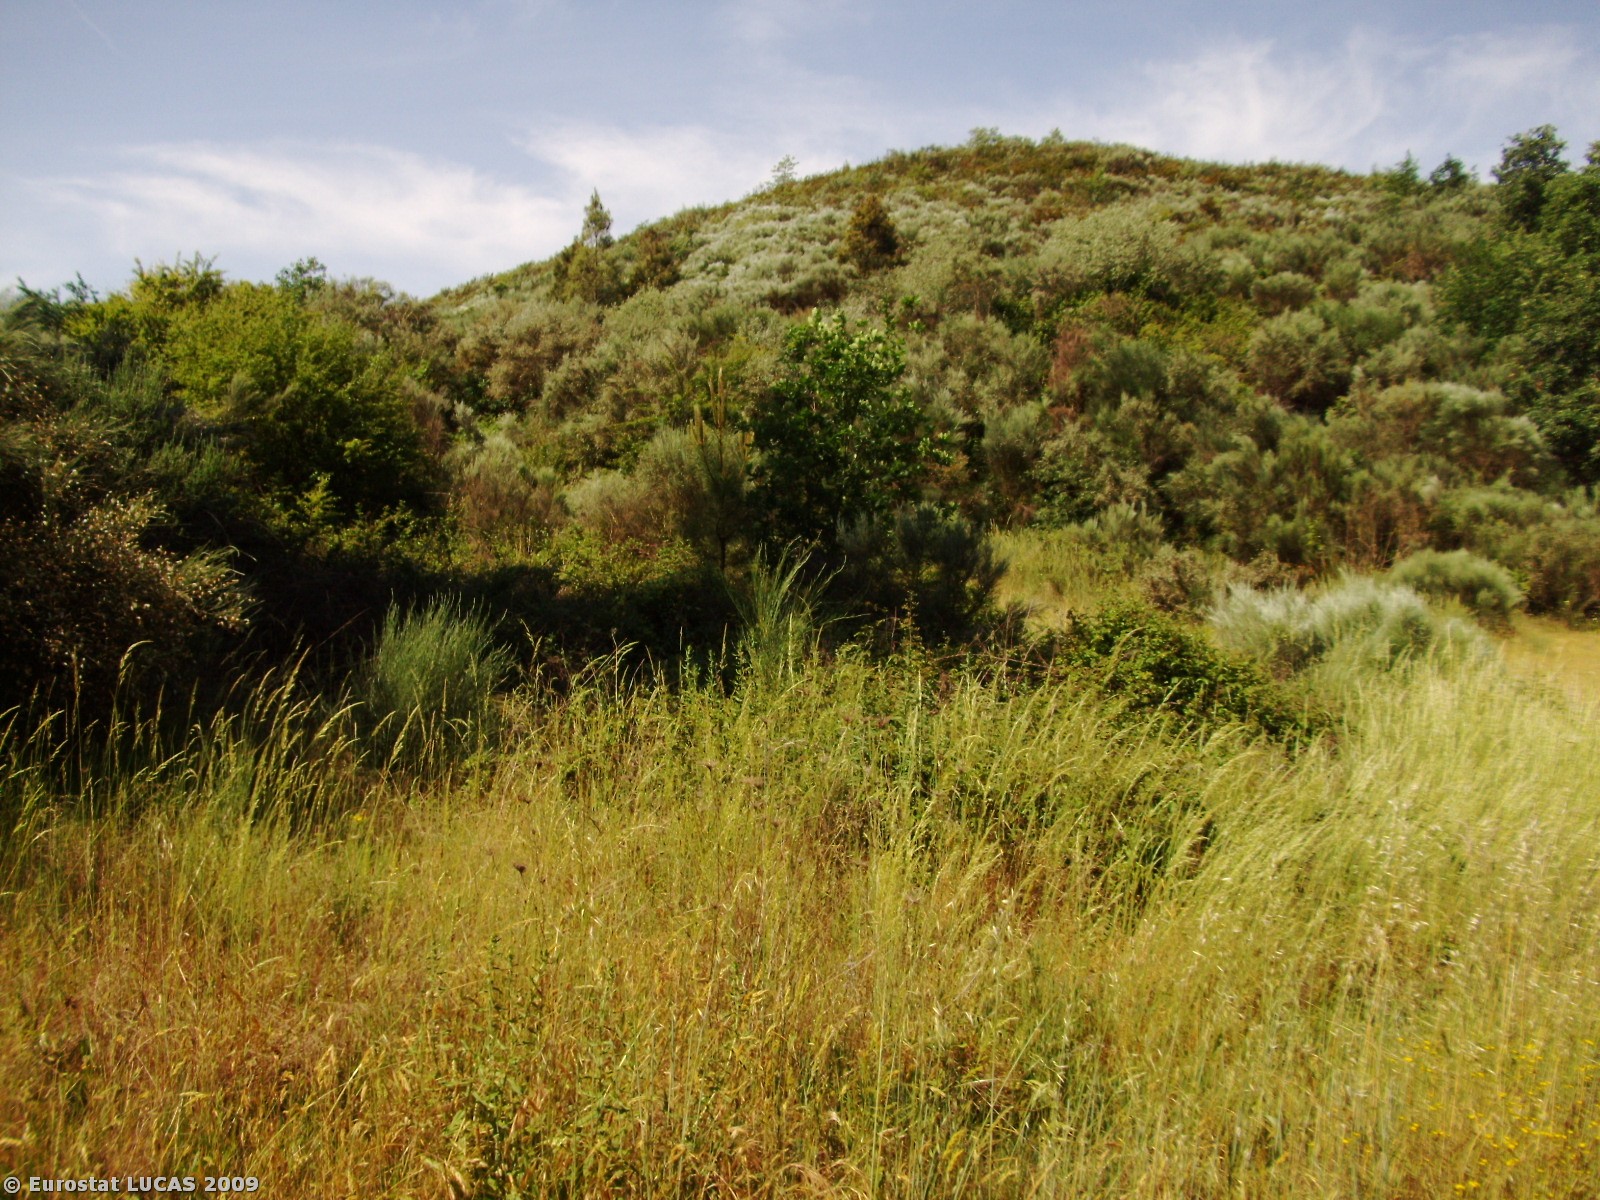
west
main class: Shrubland
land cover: Shrubland with sparse tree cover
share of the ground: > 75 %
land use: Unused
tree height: > 5 m
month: June
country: PT
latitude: 40.6224
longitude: -7.4780
